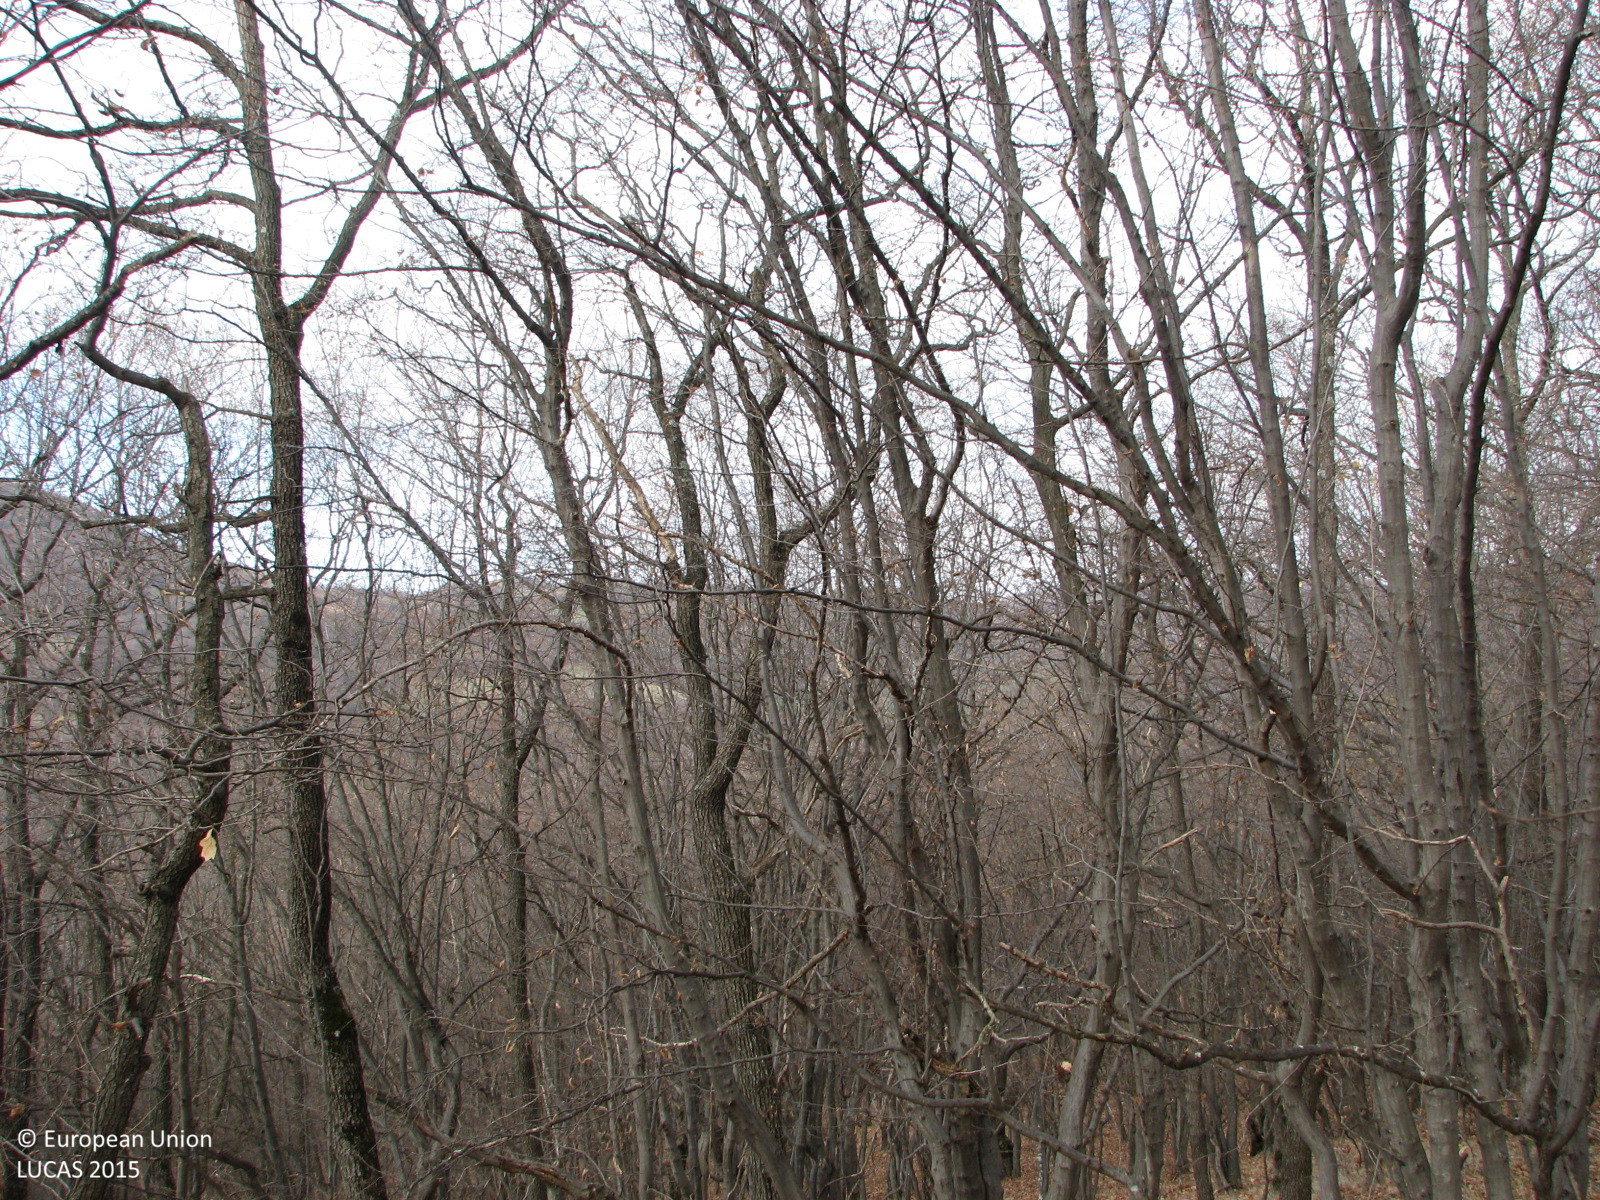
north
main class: Woodland
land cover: Broadleaved woodland
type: mesophytic deciduous forest
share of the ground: > 75 %
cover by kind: broadleaved forest trees 85 %, herbaceous plants 10 %, unconsolidated bare surface 5 %
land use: Semi-natural and natural areas not in use
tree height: < 5 m
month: December
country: BG
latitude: 42.5428
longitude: 24.0844
